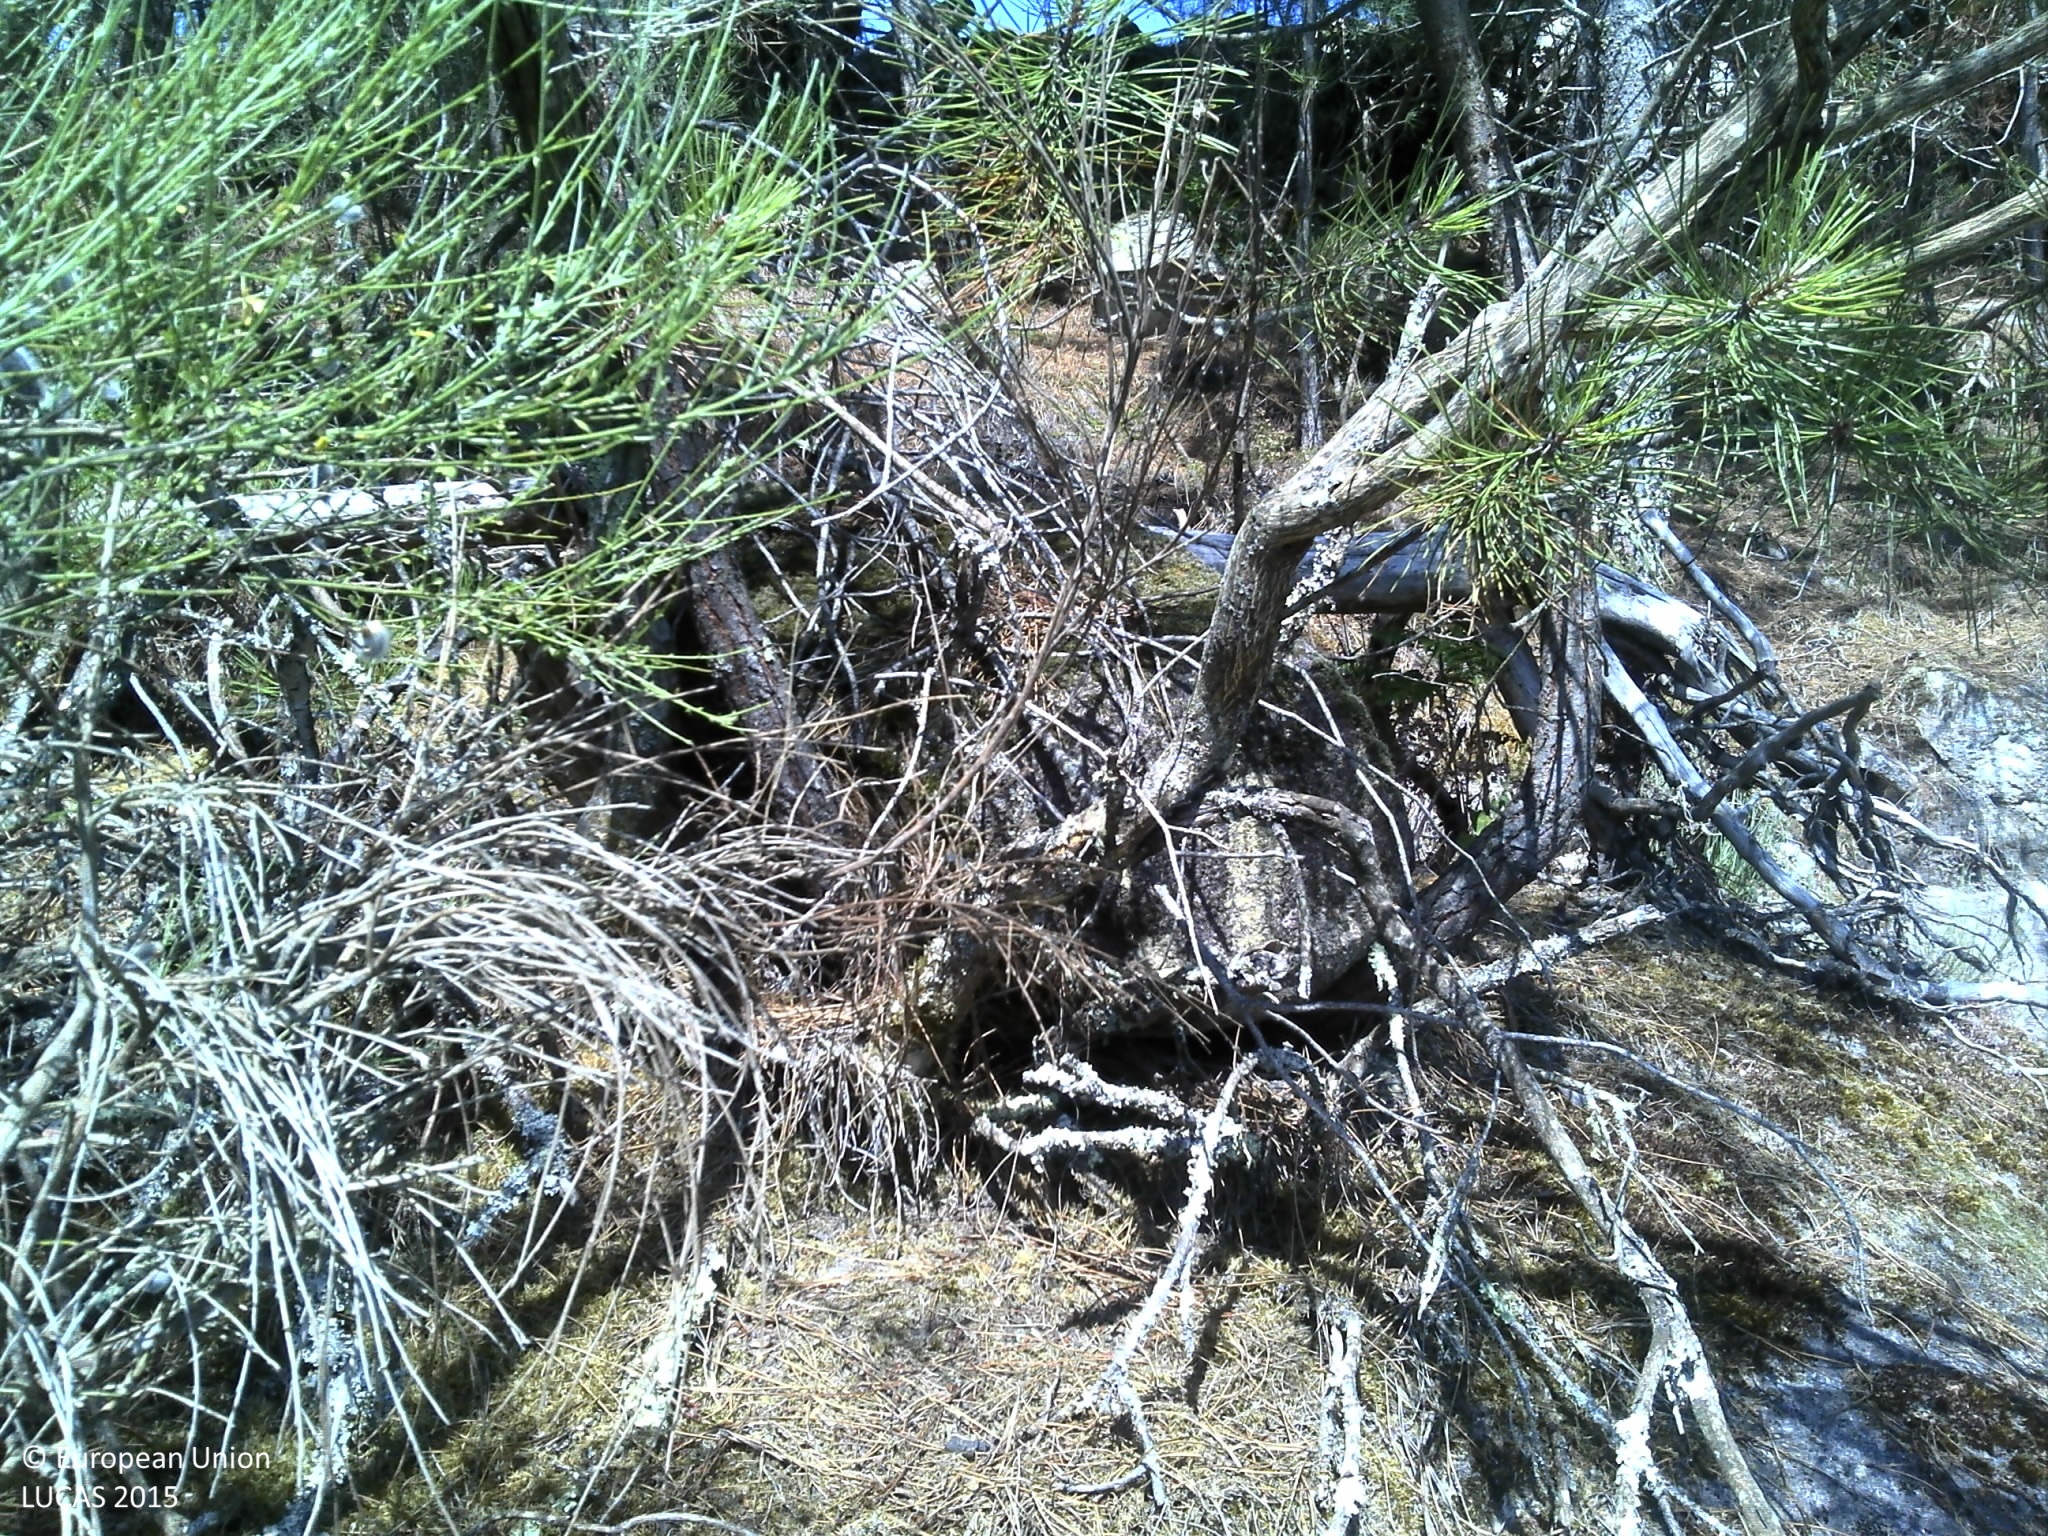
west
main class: Woodland
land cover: Pine dominated coniferous woodland
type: coniferous forest of the mediterranean region
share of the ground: 50 - 75 %
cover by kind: coniferous forest trees 65 %, shrubs 30 %, unconsolidated bare surface 5 %
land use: Semi-natural and natural areas not in use
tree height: > 5 m
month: July
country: PT
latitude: 41.5523
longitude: -7.8453
